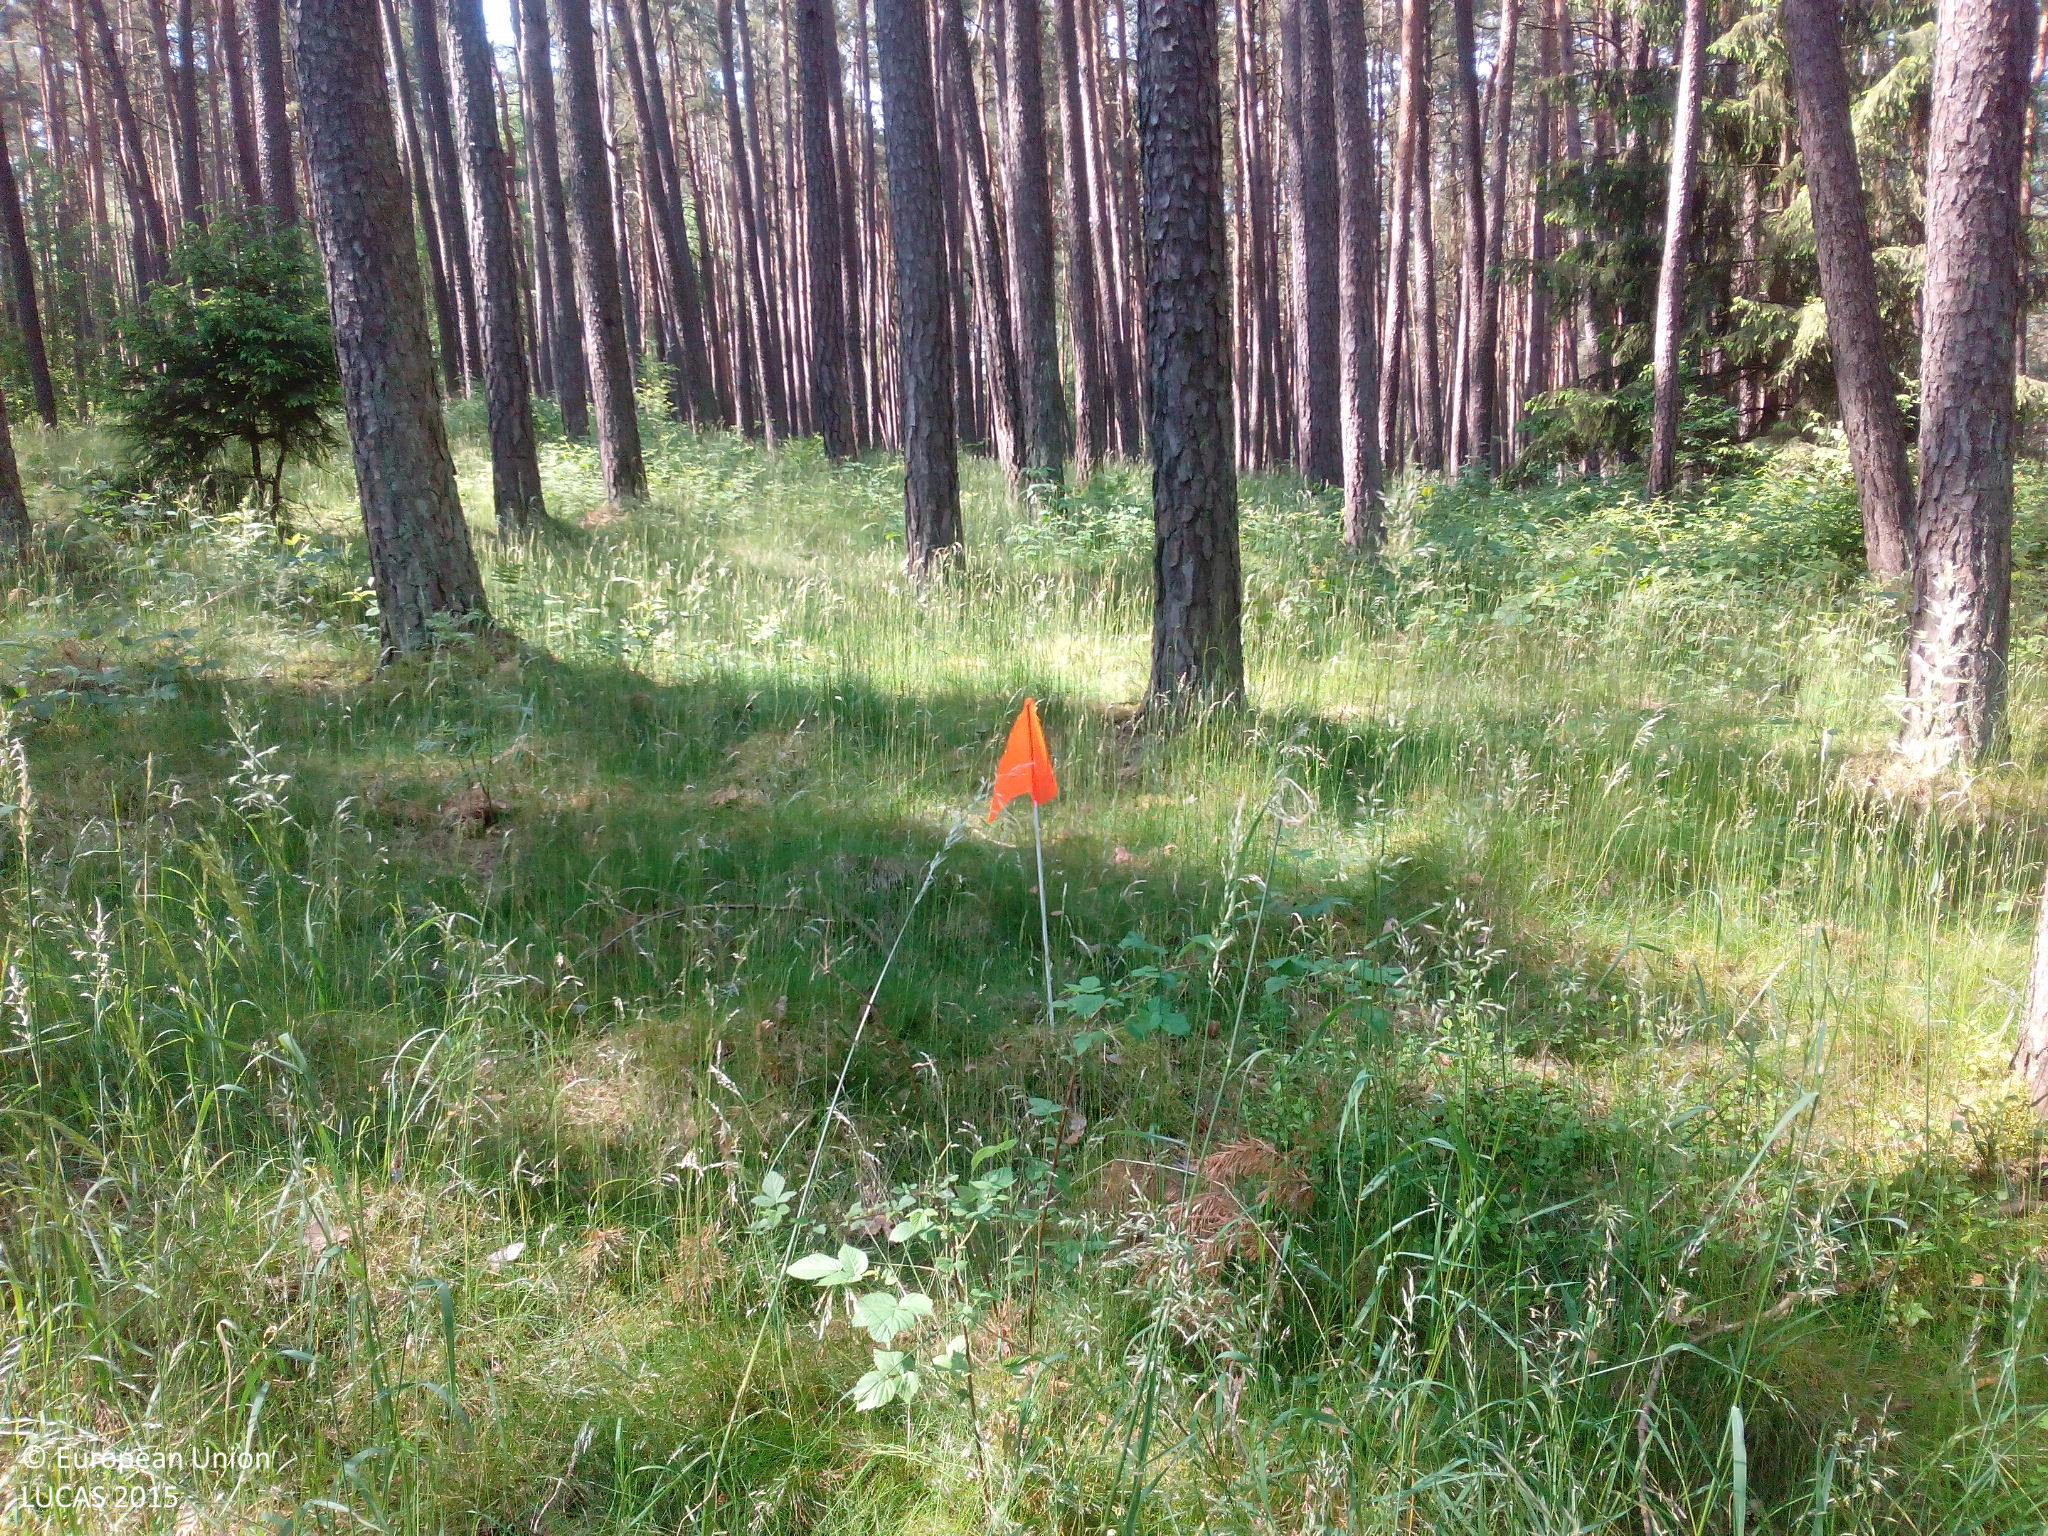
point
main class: Woodland
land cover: Pine dominated coniferous woodland
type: hemiboreal forest and nemoral coniferous forest and mixed broadleaved-coniferous forest
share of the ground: > 75 %
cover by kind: coniferous forest trees 75 %, herbaceous plants 15 %, shrubs 10 %
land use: Forestry
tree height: > 5 m
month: June
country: DE
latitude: 49.3711
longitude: 12.2167
